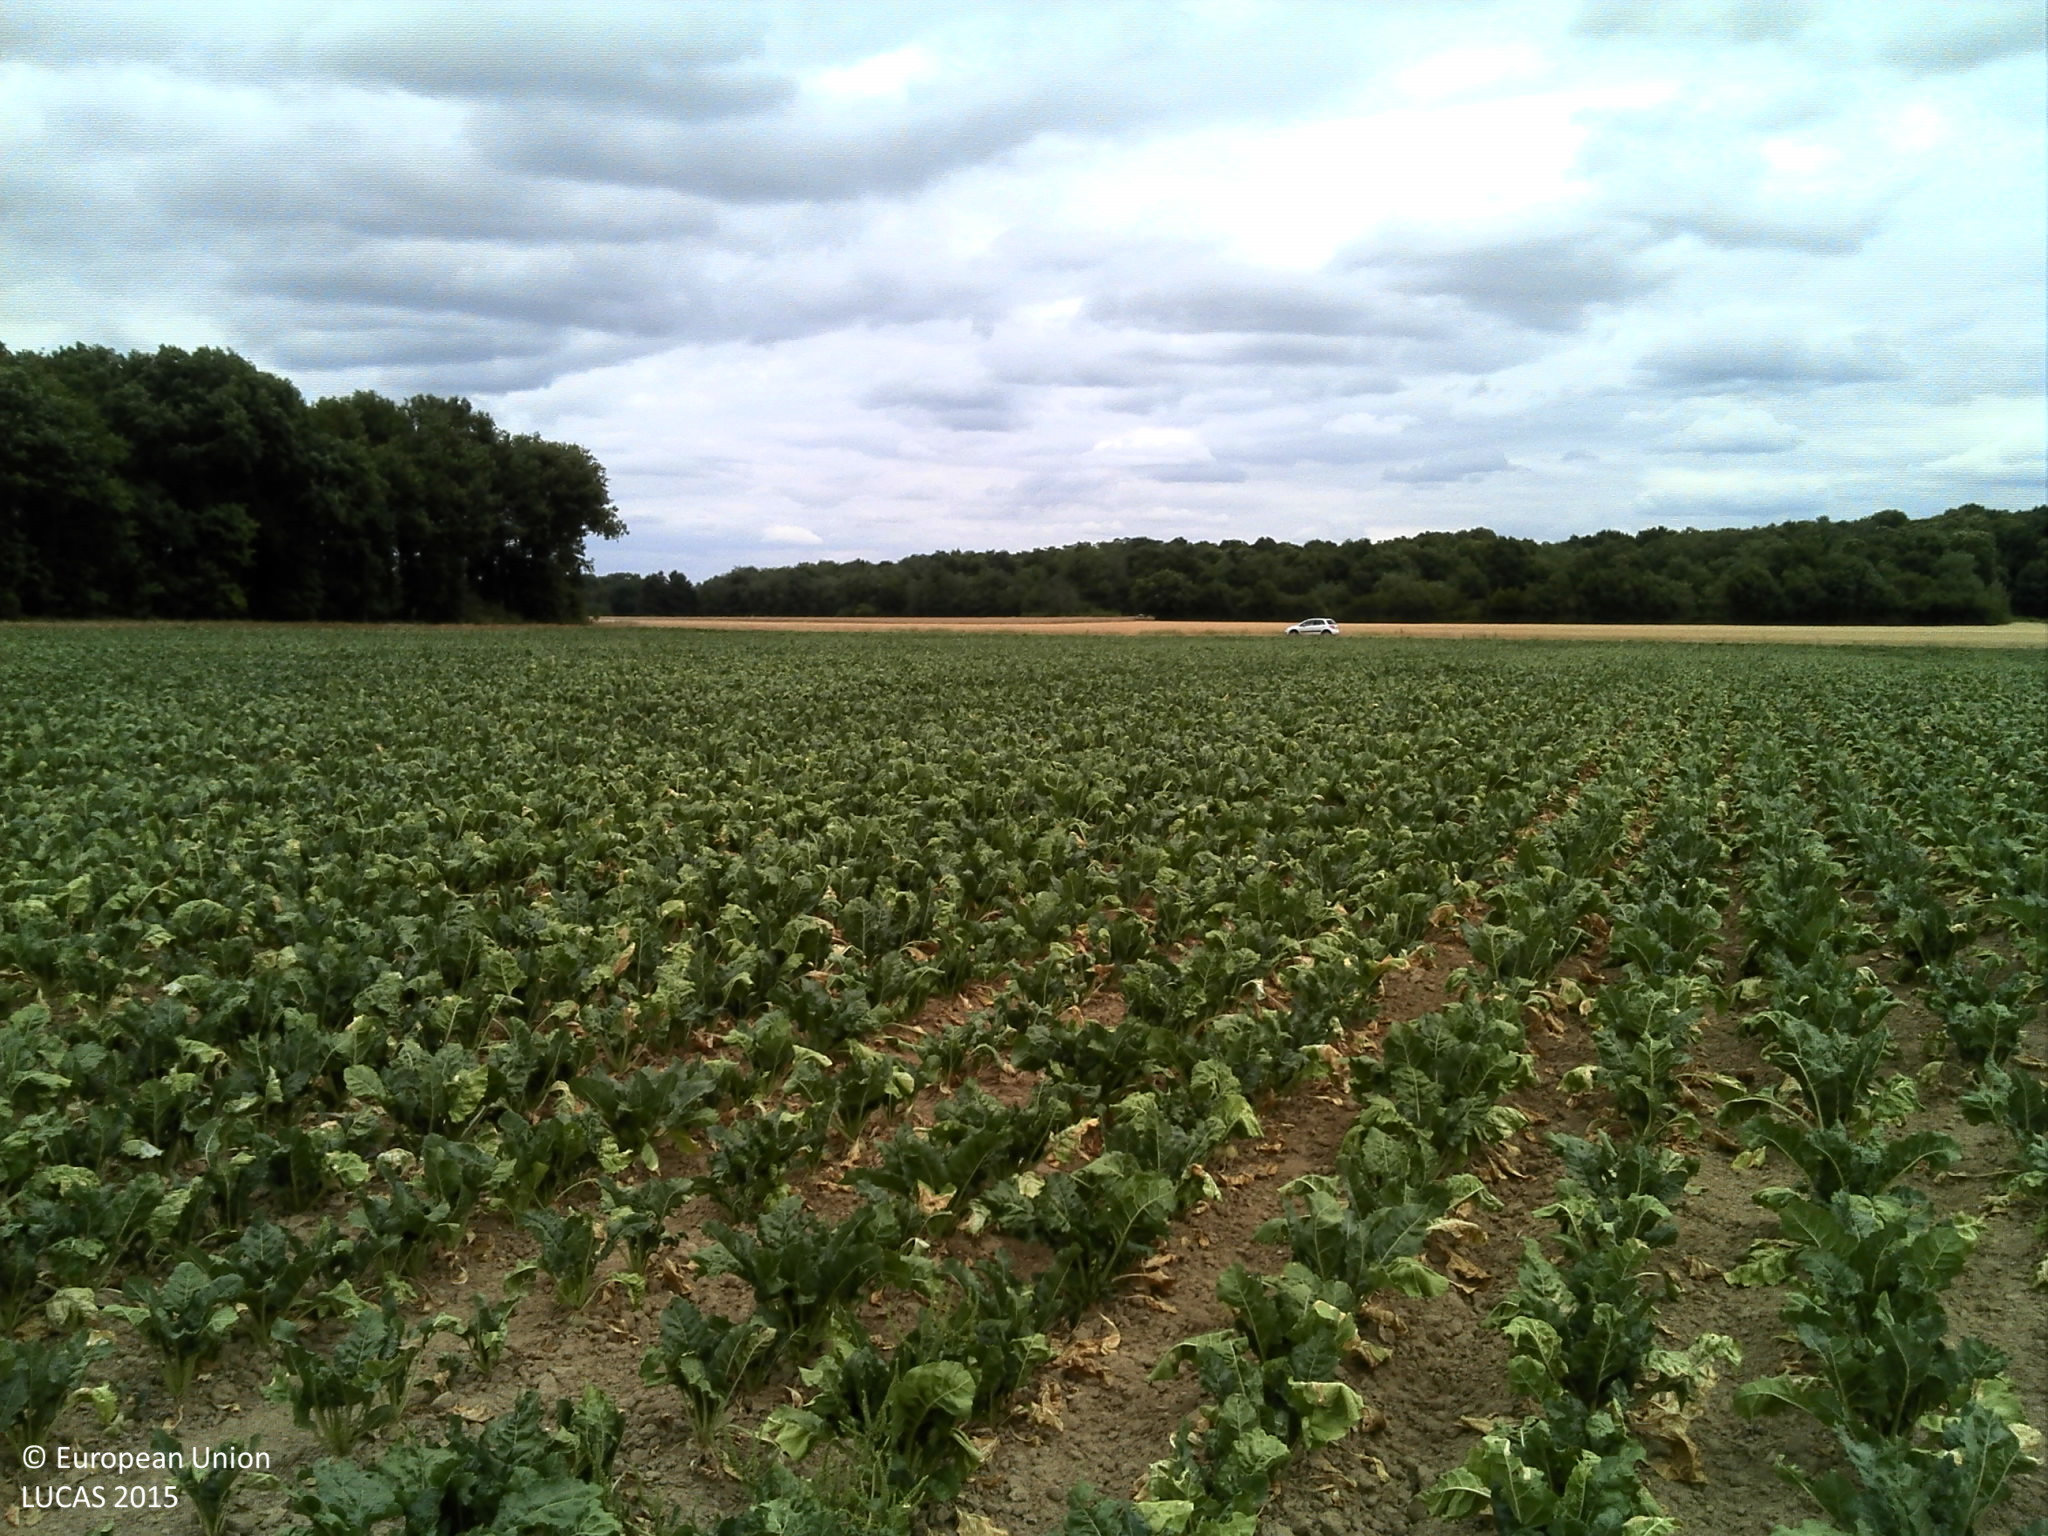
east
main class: Cropland
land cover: Sugar beet
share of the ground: 50 - 75 %
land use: Agriculture (excluding fallow land and kitchen gardens)
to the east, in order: Sugar beet; Grass margins; Tracks; Grass margins; Common wheat; Grass margins
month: July
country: FR
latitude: 48.4905
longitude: 2.4795
